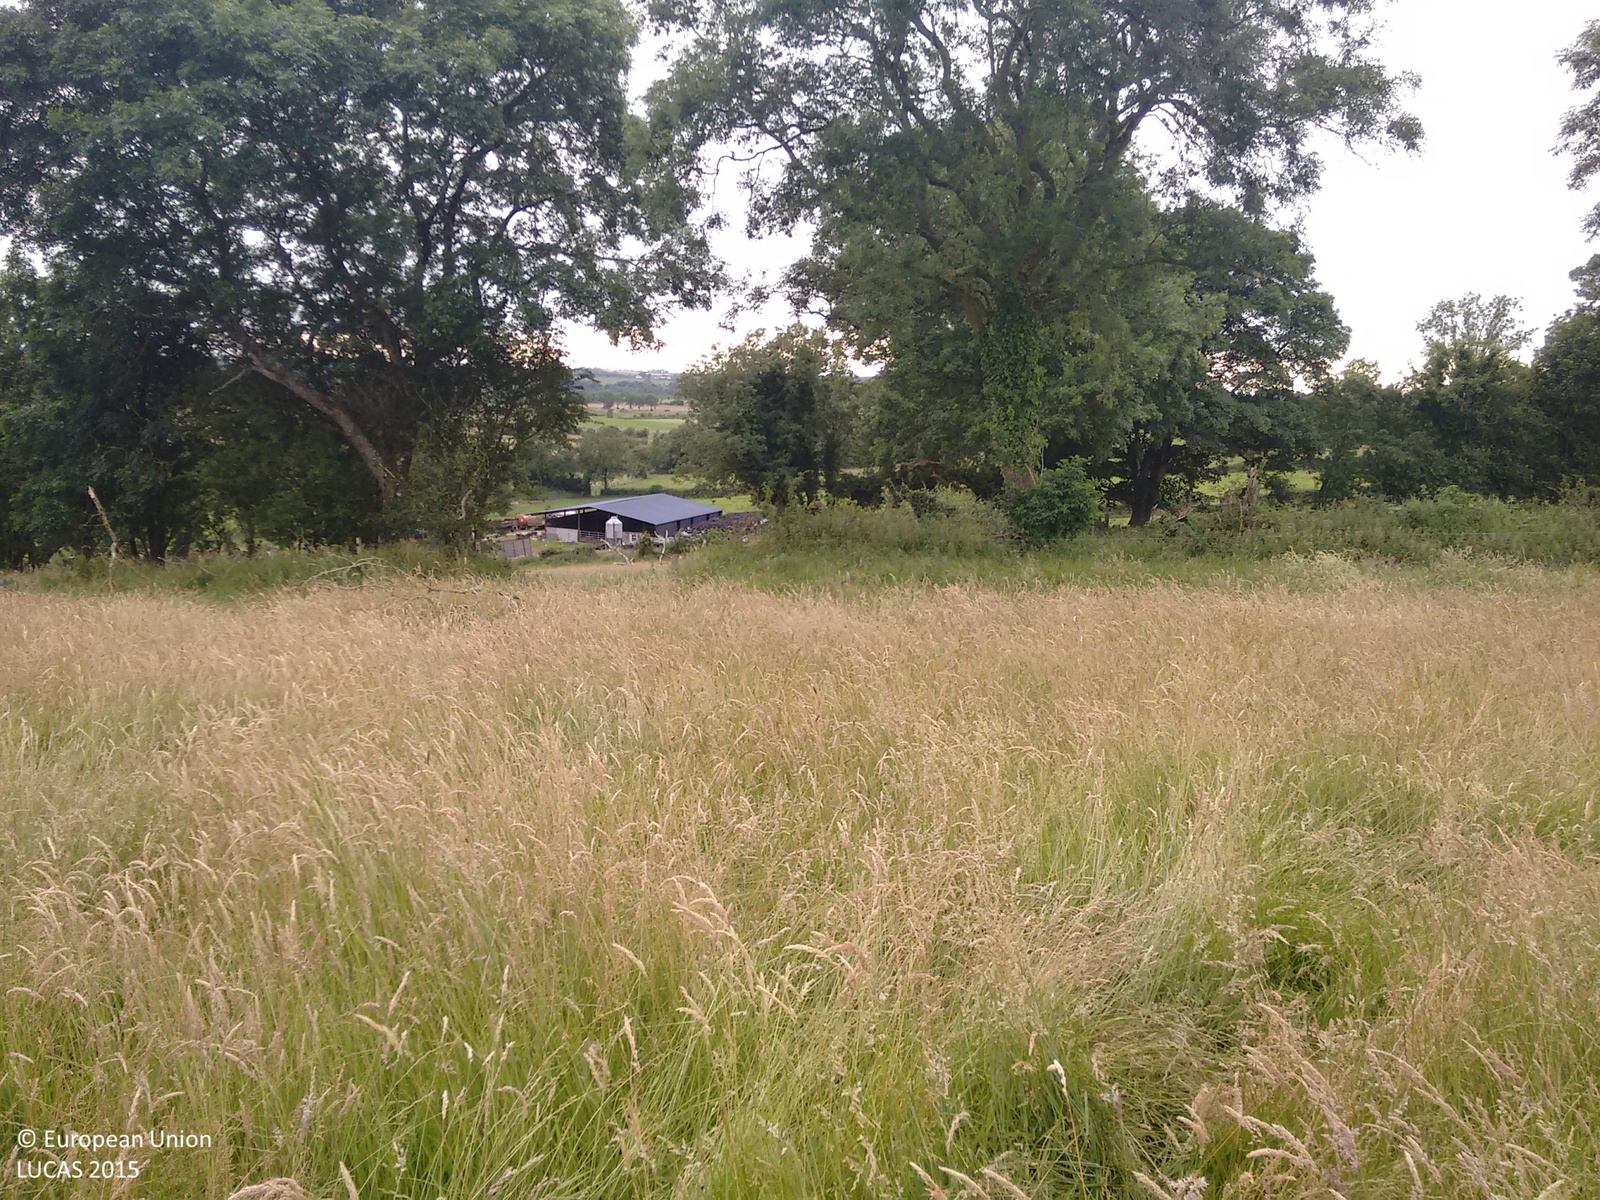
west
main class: Grassland
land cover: Grassland without tree/shrub cover
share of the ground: > 75 %
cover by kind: herbaceous plants 100 %
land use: Agriculture (excluding fallow land and kitchen gardens)
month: July
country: IE
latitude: 53.4678
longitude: -7.6837
